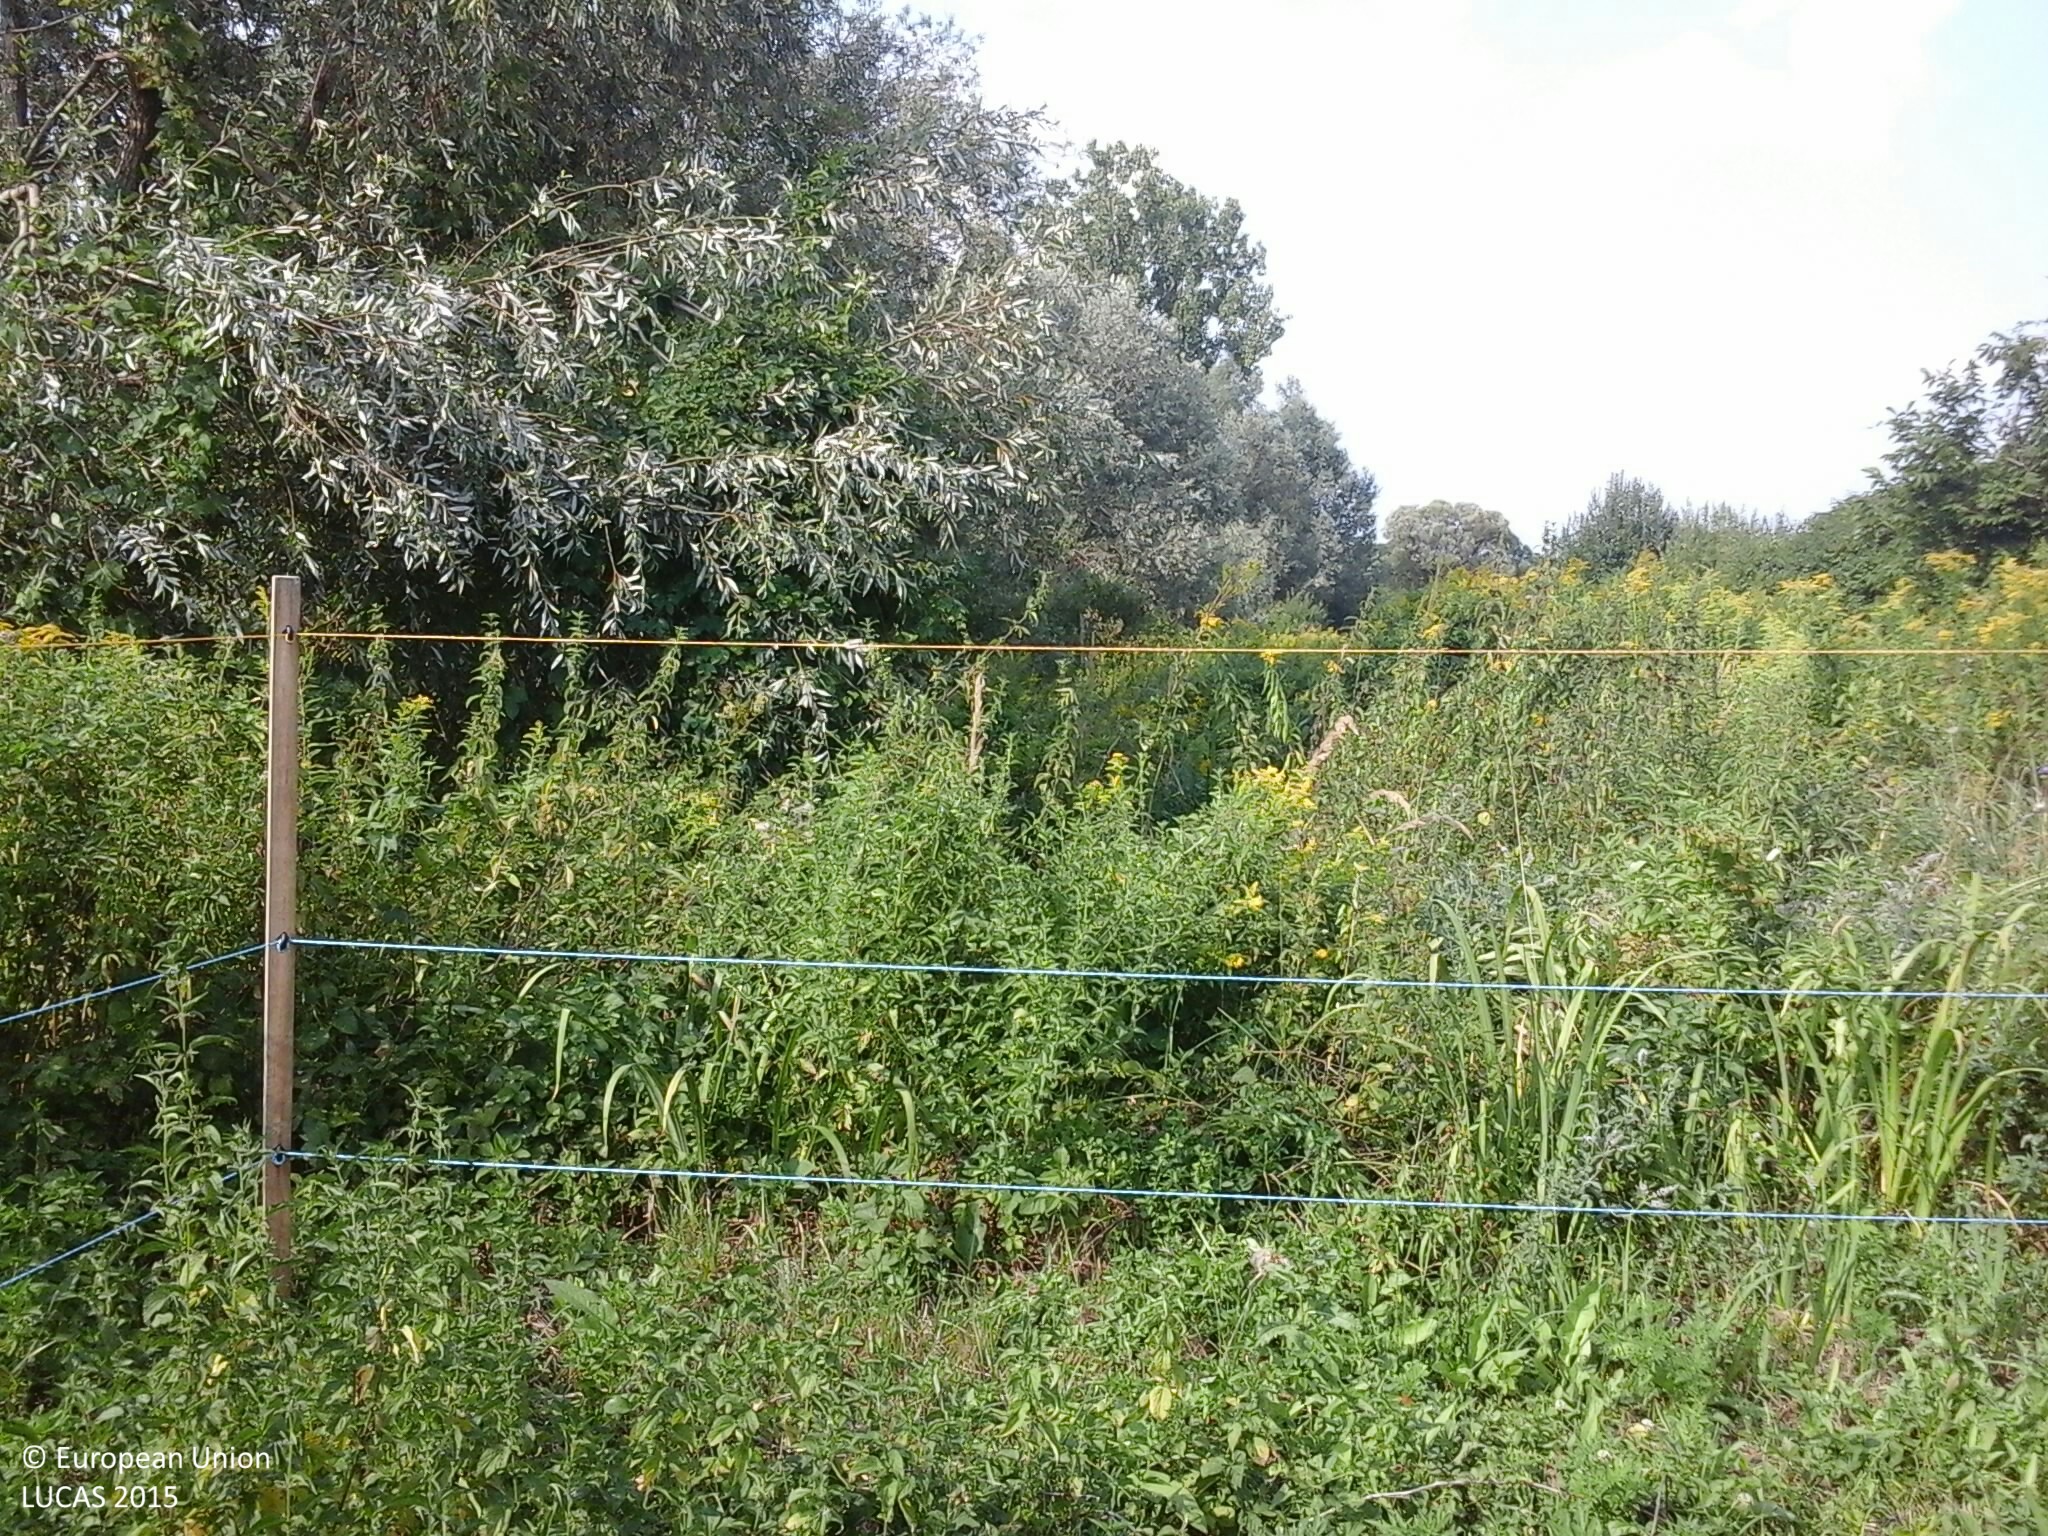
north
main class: Grassland
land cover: Spontaneously vegetated surfaces
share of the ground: > 75 %
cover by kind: herbaceous plants 100 %
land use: Fallow land
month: August
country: HU
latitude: 45.9377
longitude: 18.3004
